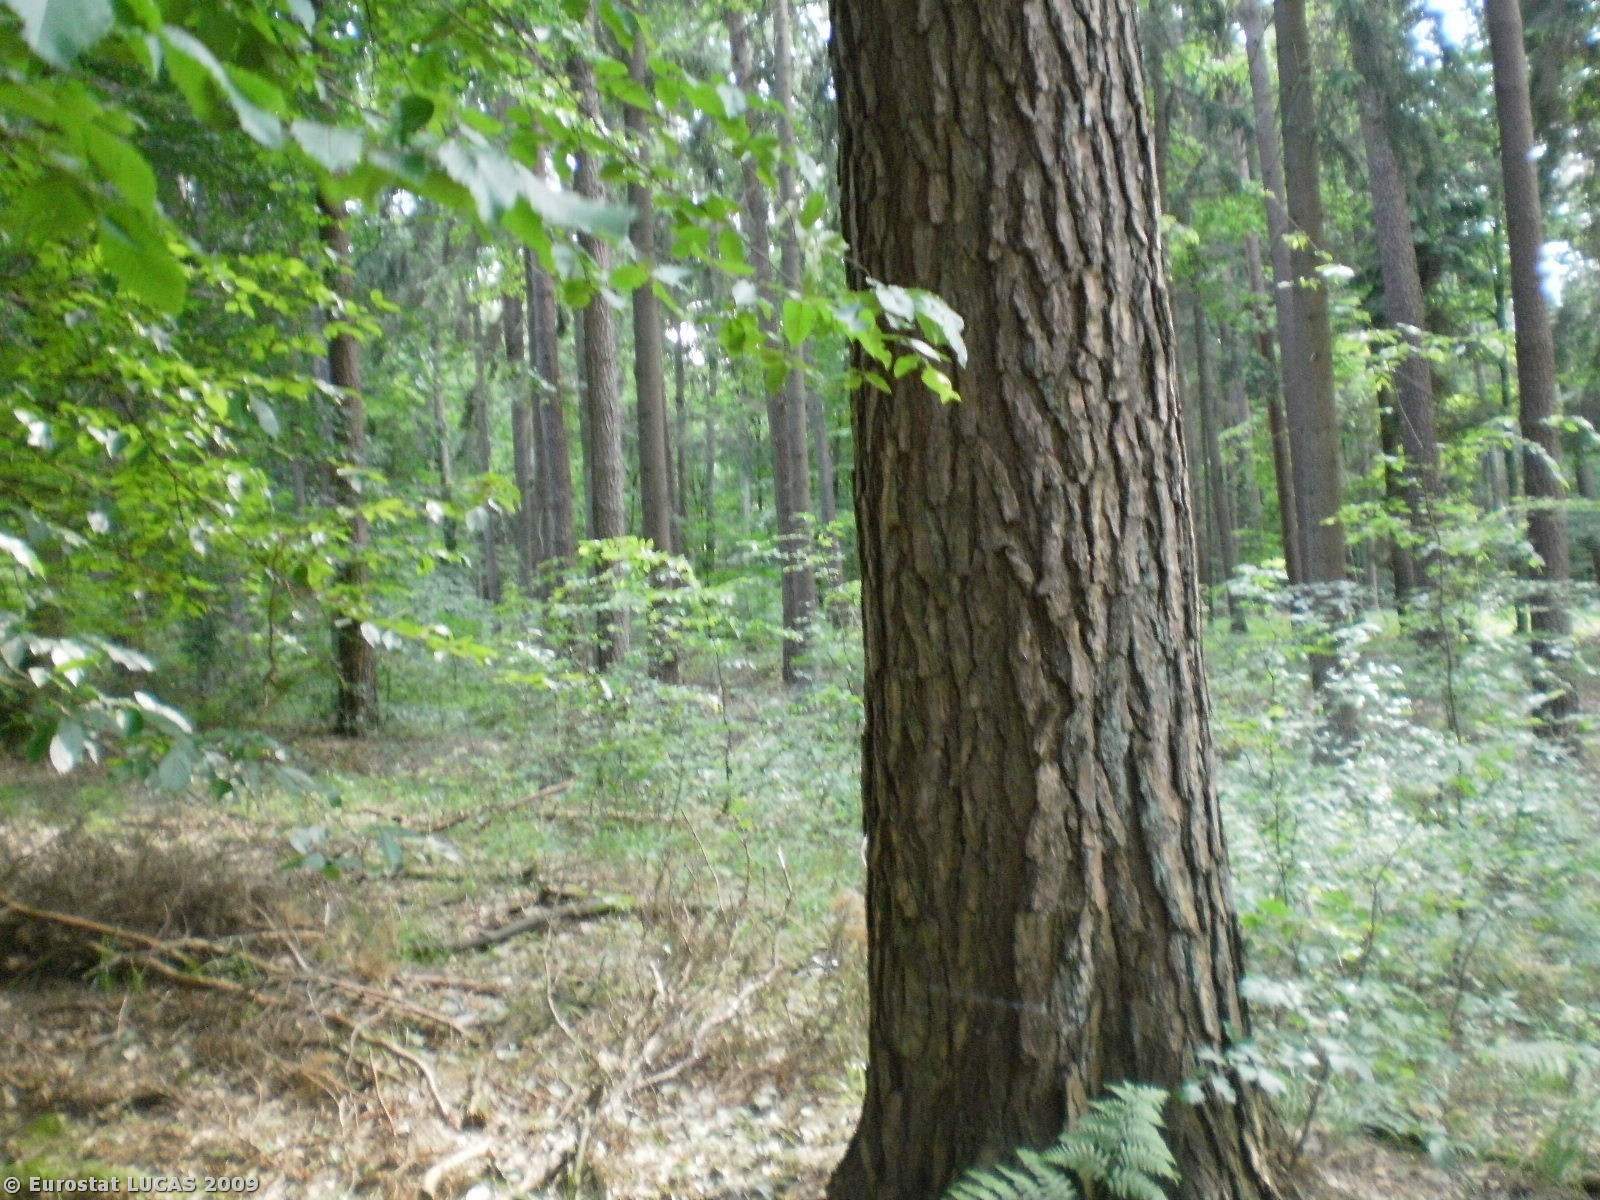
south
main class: Woodland
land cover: Mixed woodland
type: hemiboreal forest and nemoral coniferous forest and mixed broadleaved-coniferous forest
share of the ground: > 75 %
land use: Forestry
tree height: > 5 m
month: June
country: PL
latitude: 53.7228
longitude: 19.8657
